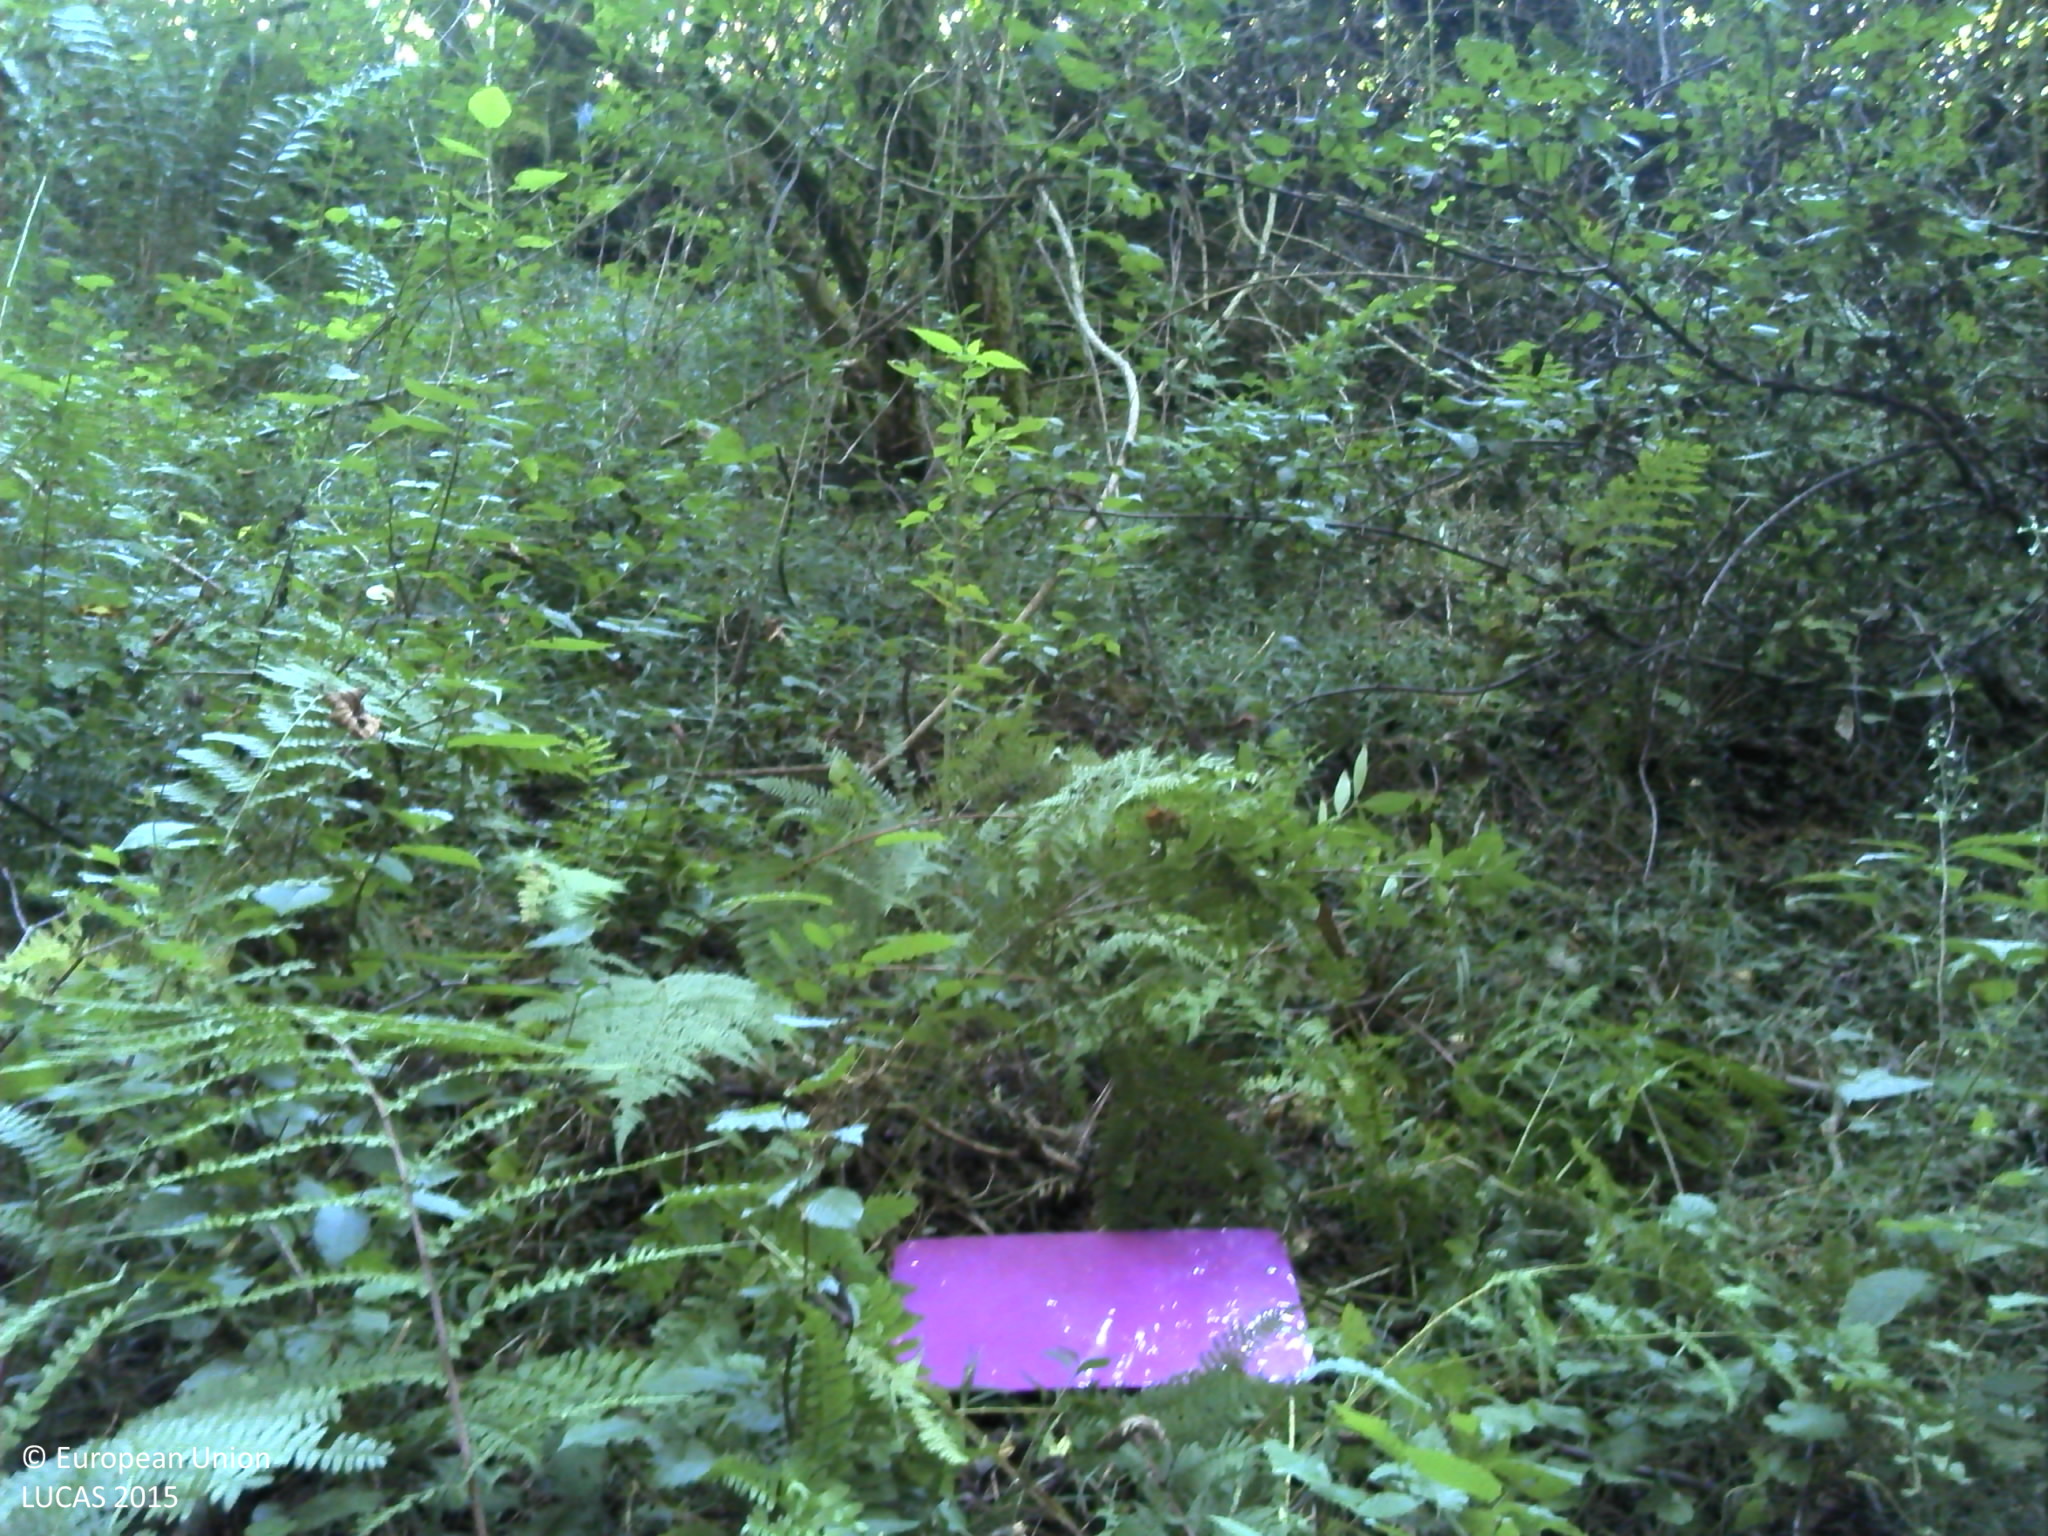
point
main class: Woodland
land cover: Broadleaved woodland
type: beech forest
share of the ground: > 75 %
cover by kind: broadleaved forest trees 100 %
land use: Forestry
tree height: > 5 m
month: August
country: HR
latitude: 45.1165
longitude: 16.3142
